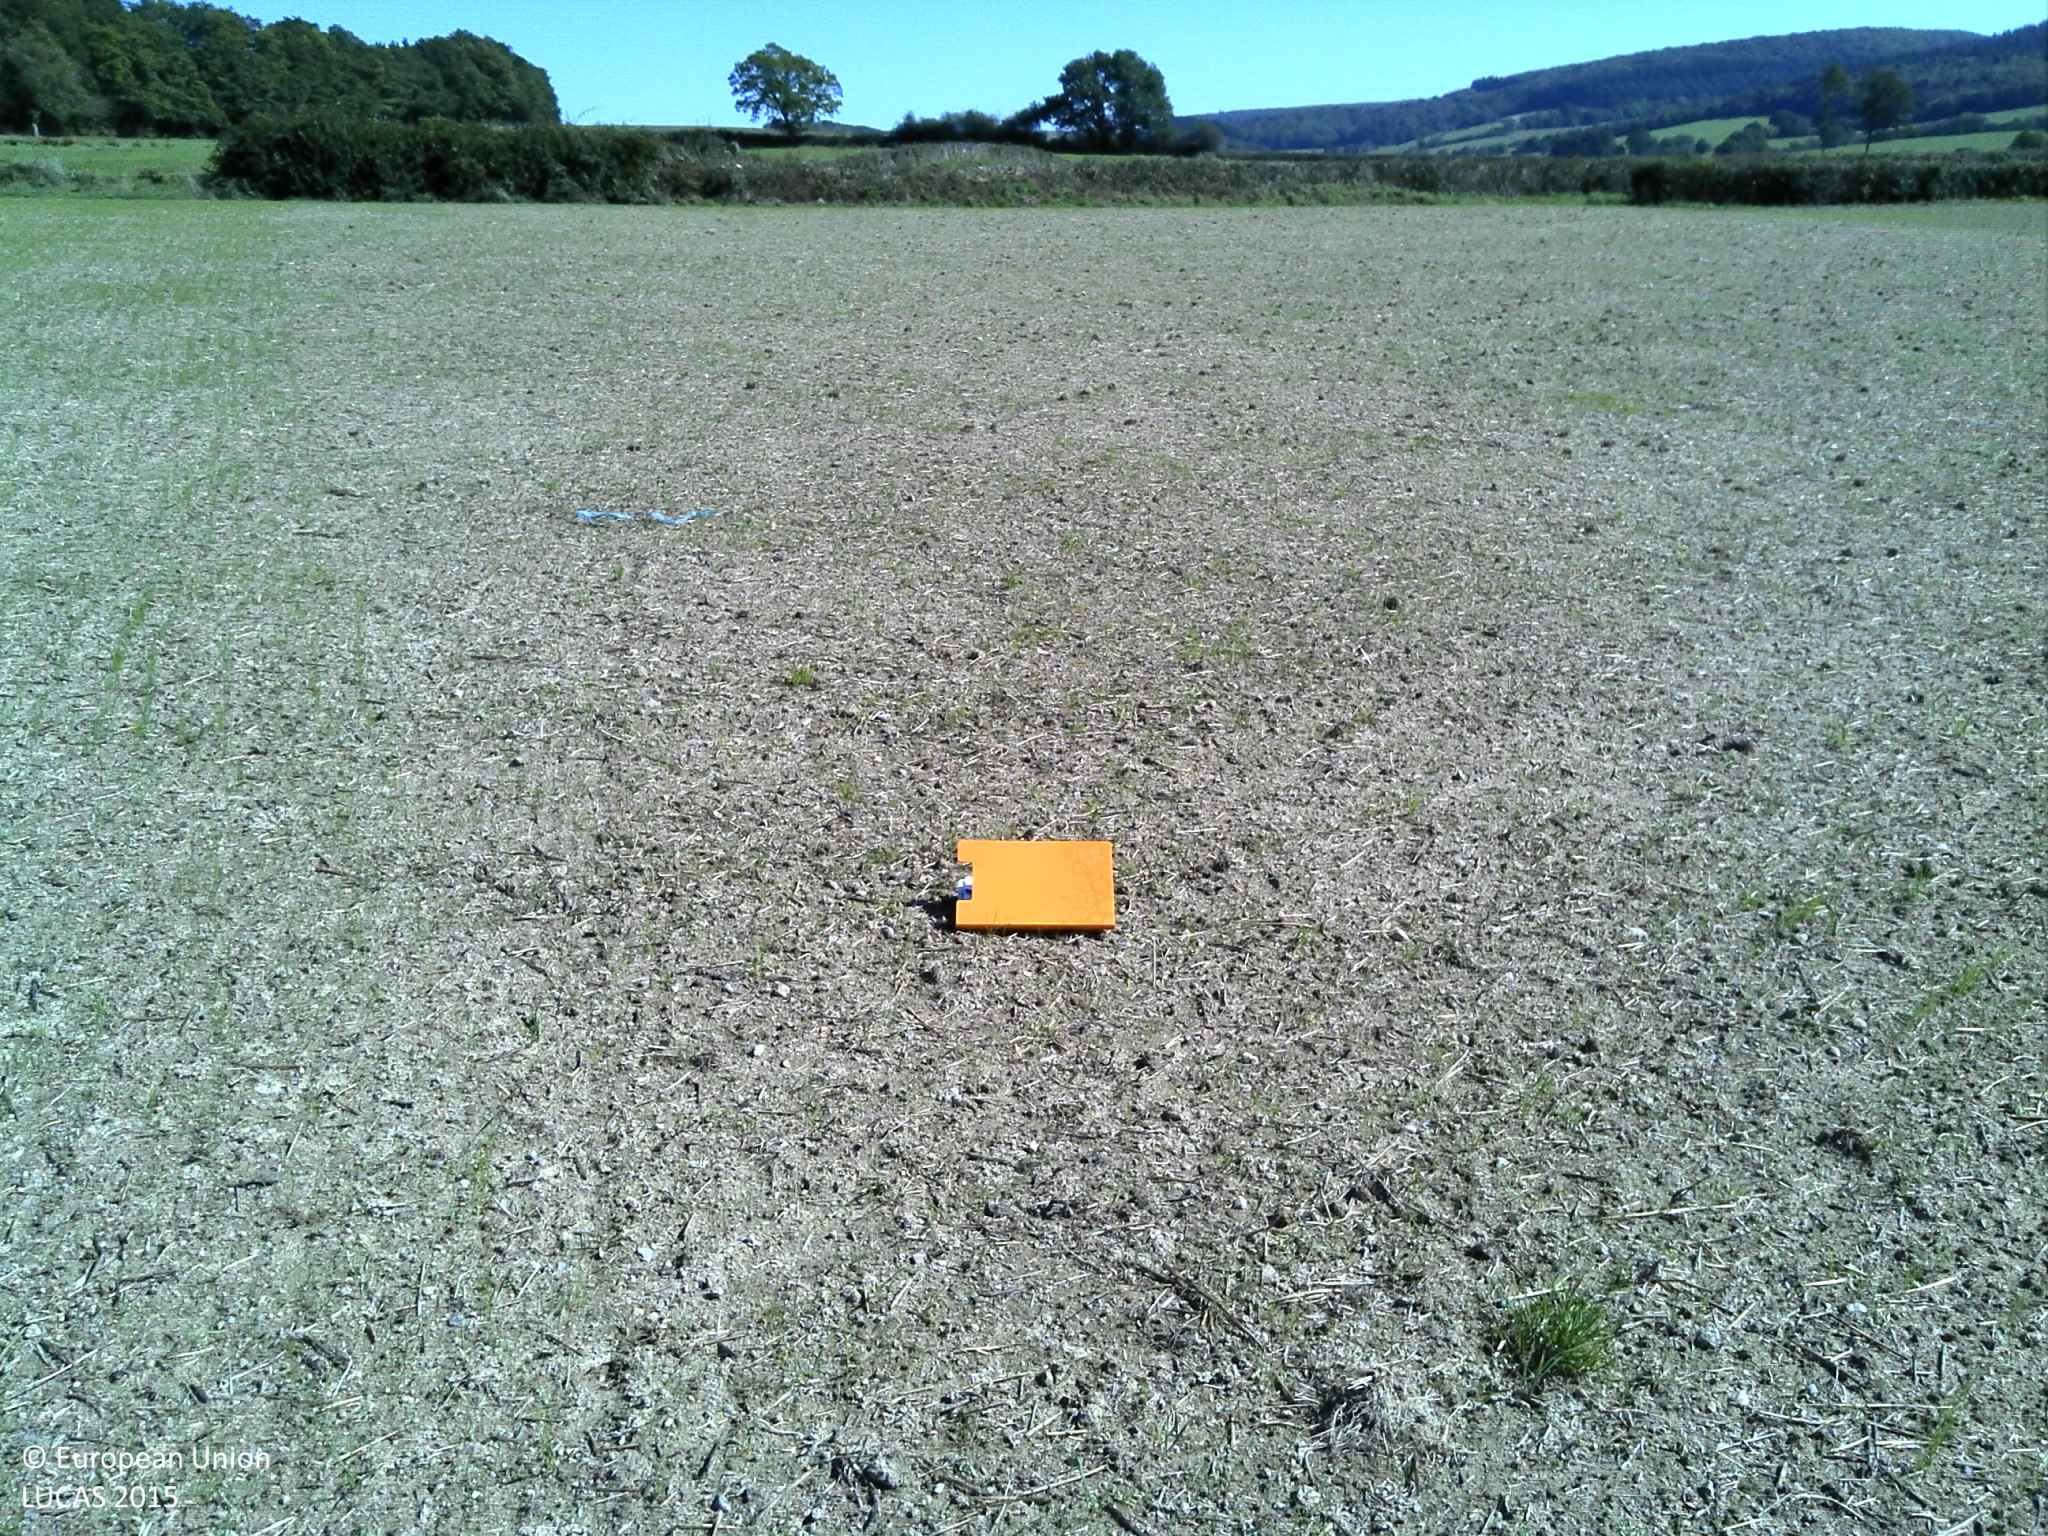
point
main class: Cropland
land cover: Common wheat
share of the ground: < 10 %
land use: Agriculture (excluding fallow land and kitchen gardens)
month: September
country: FR
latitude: 46.9786
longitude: 4.3603
